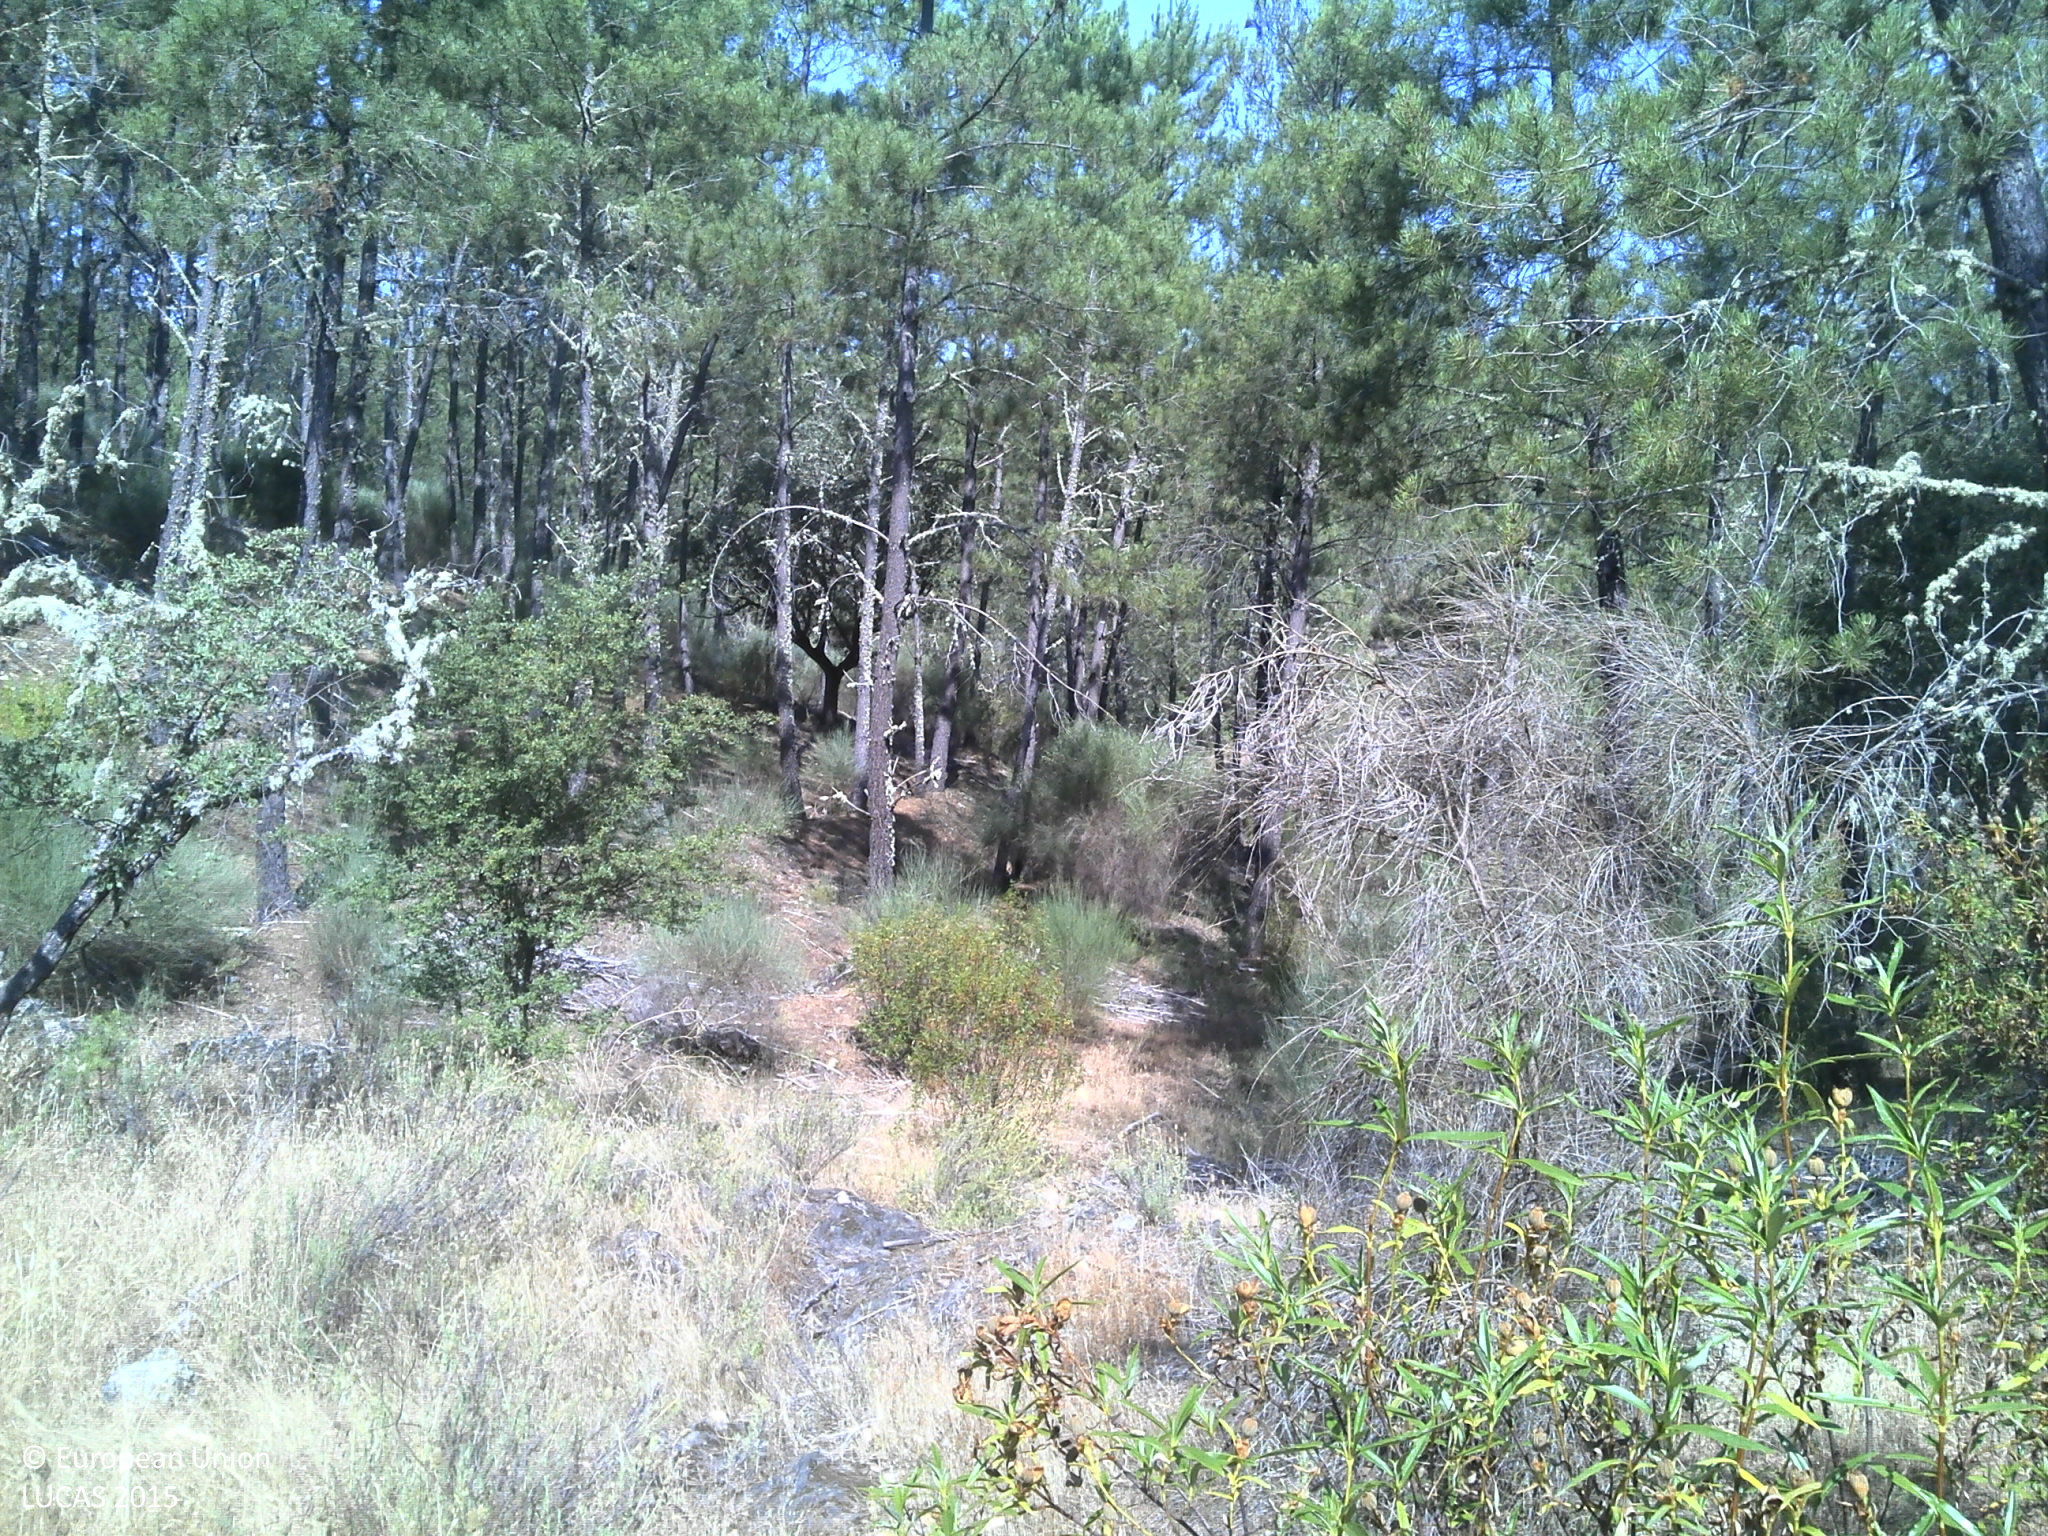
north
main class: Woodland
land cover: Pine dominated coniferous woodland
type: coniferous forest of the mediterranean region
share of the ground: 25 - 50 %
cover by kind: coniferous forest trees 50 %, shrubs 30 %, unconsolidated bare surface 20 %
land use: Forestry
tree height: > 5 m
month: June
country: PT
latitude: 40.1078
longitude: -6.9497
